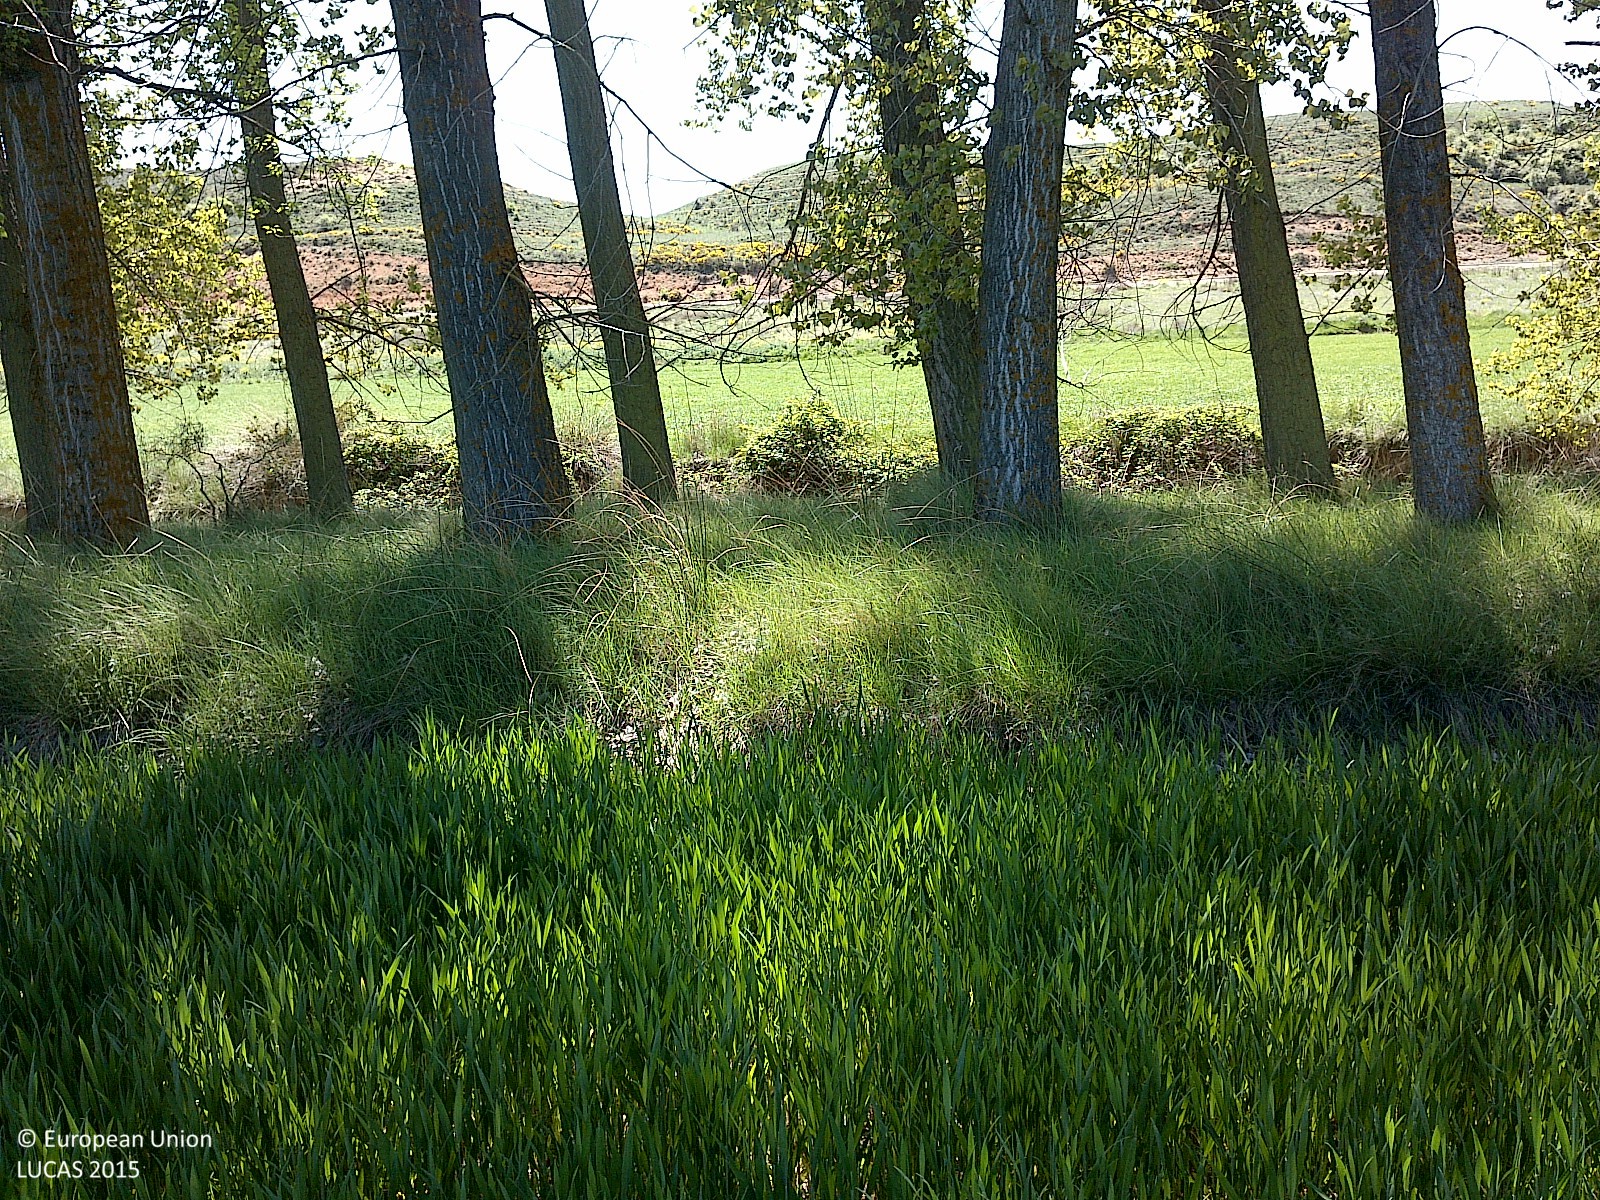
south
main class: Cropland
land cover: Barley
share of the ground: > 75 %
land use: Agriculture (excluding fallow land and kitchen gardens)
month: May
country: ES
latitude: 41.5812
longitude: -3.2273
